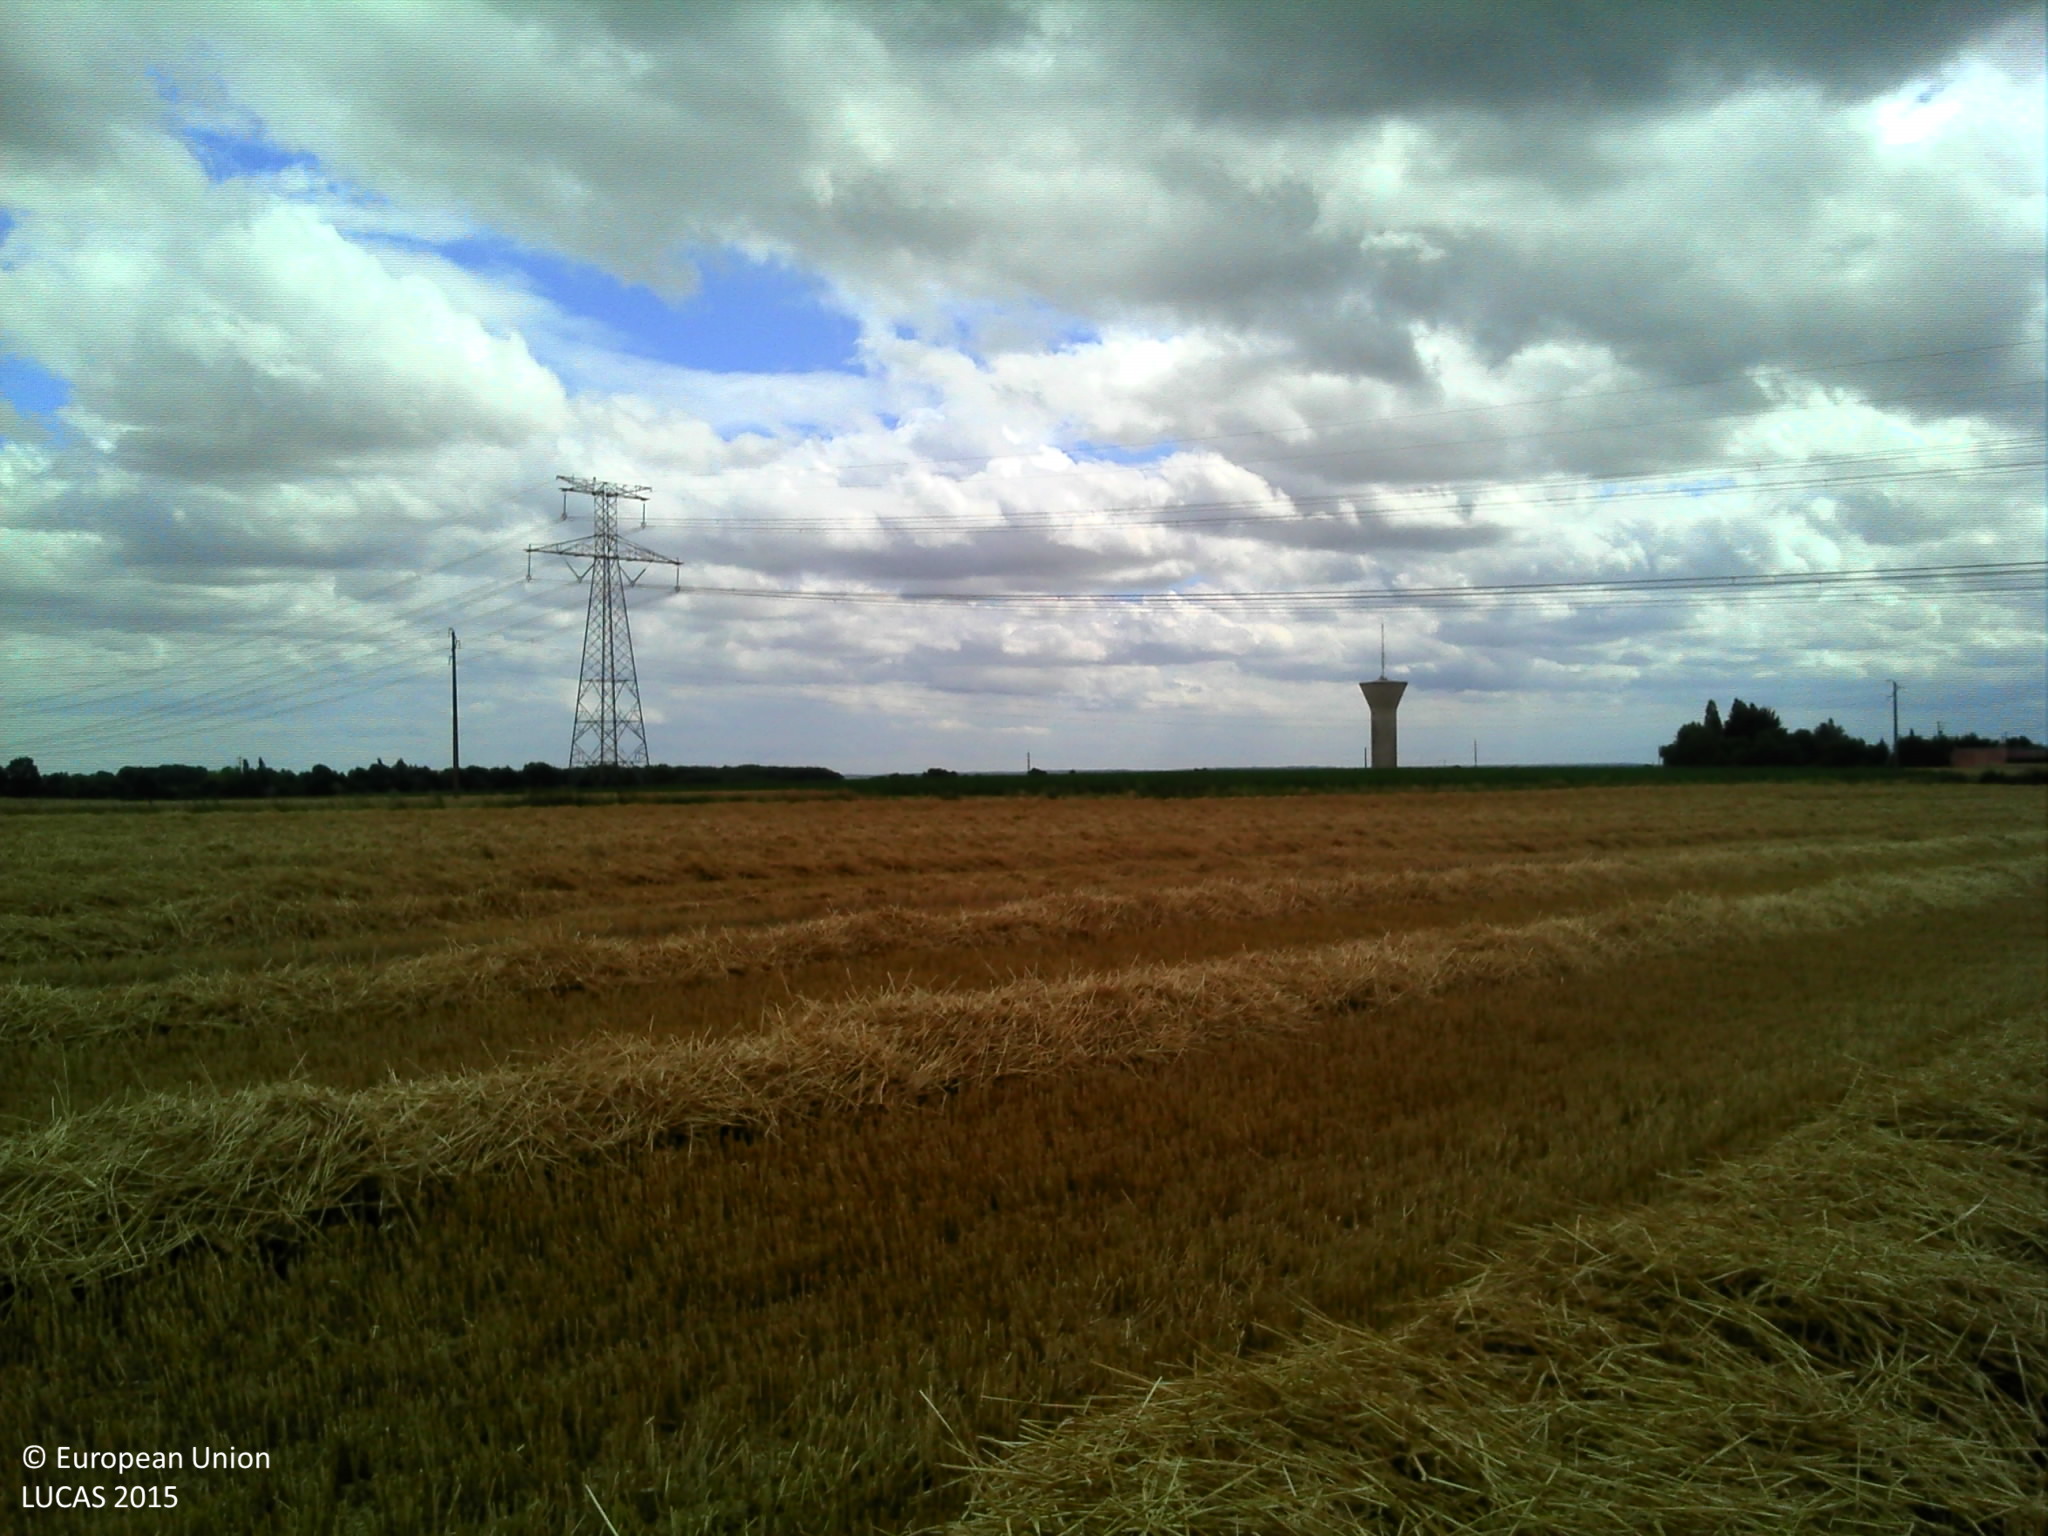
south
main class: Cropland
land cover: Common wheat
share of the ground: > 75 %
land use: Agriculture (excluding fallow land and kitchen gardens)
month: July
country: FR
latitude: 47.7171
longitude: 0.4462
